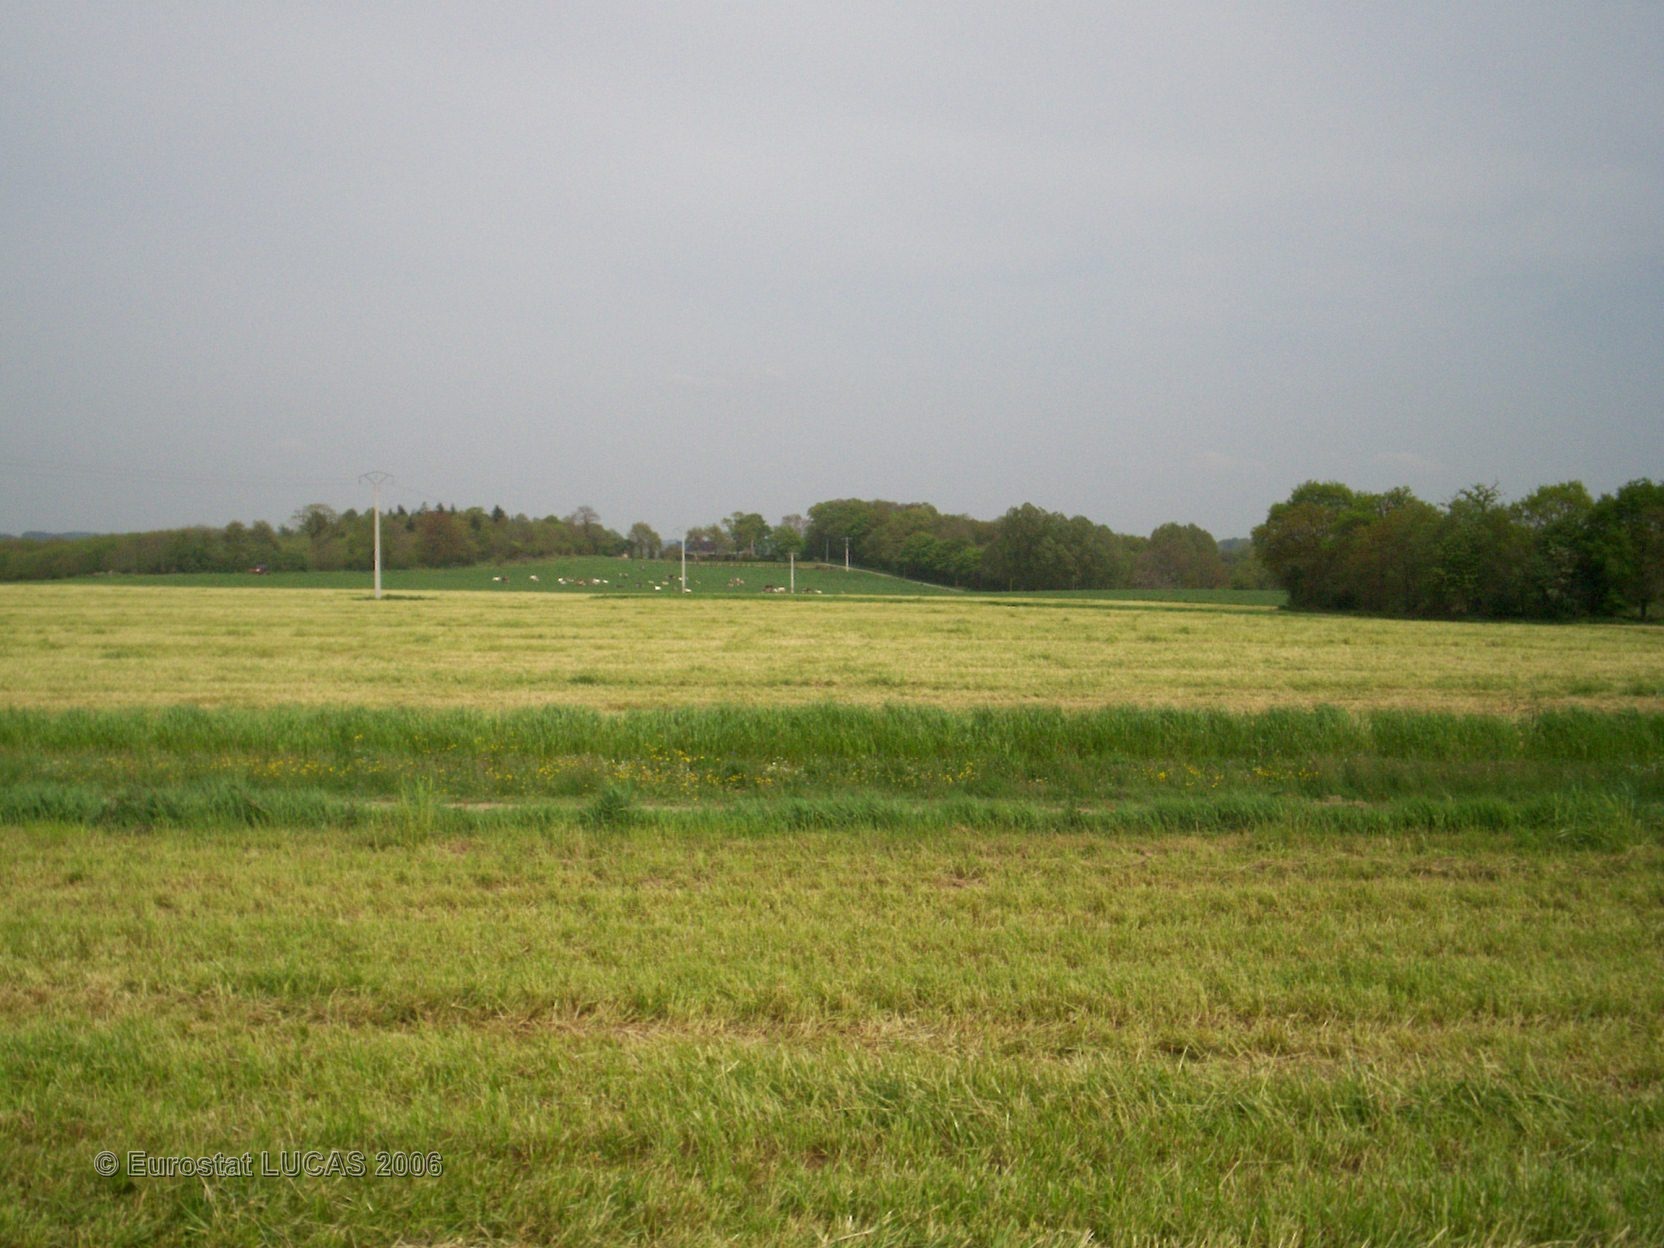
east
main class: Grassland
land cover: Grassland without tree/shrub cover
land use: Agriculture (excluding fallow land and kitchen gardens)
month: May
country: FR
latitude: 47.7221
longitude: -2.2255
